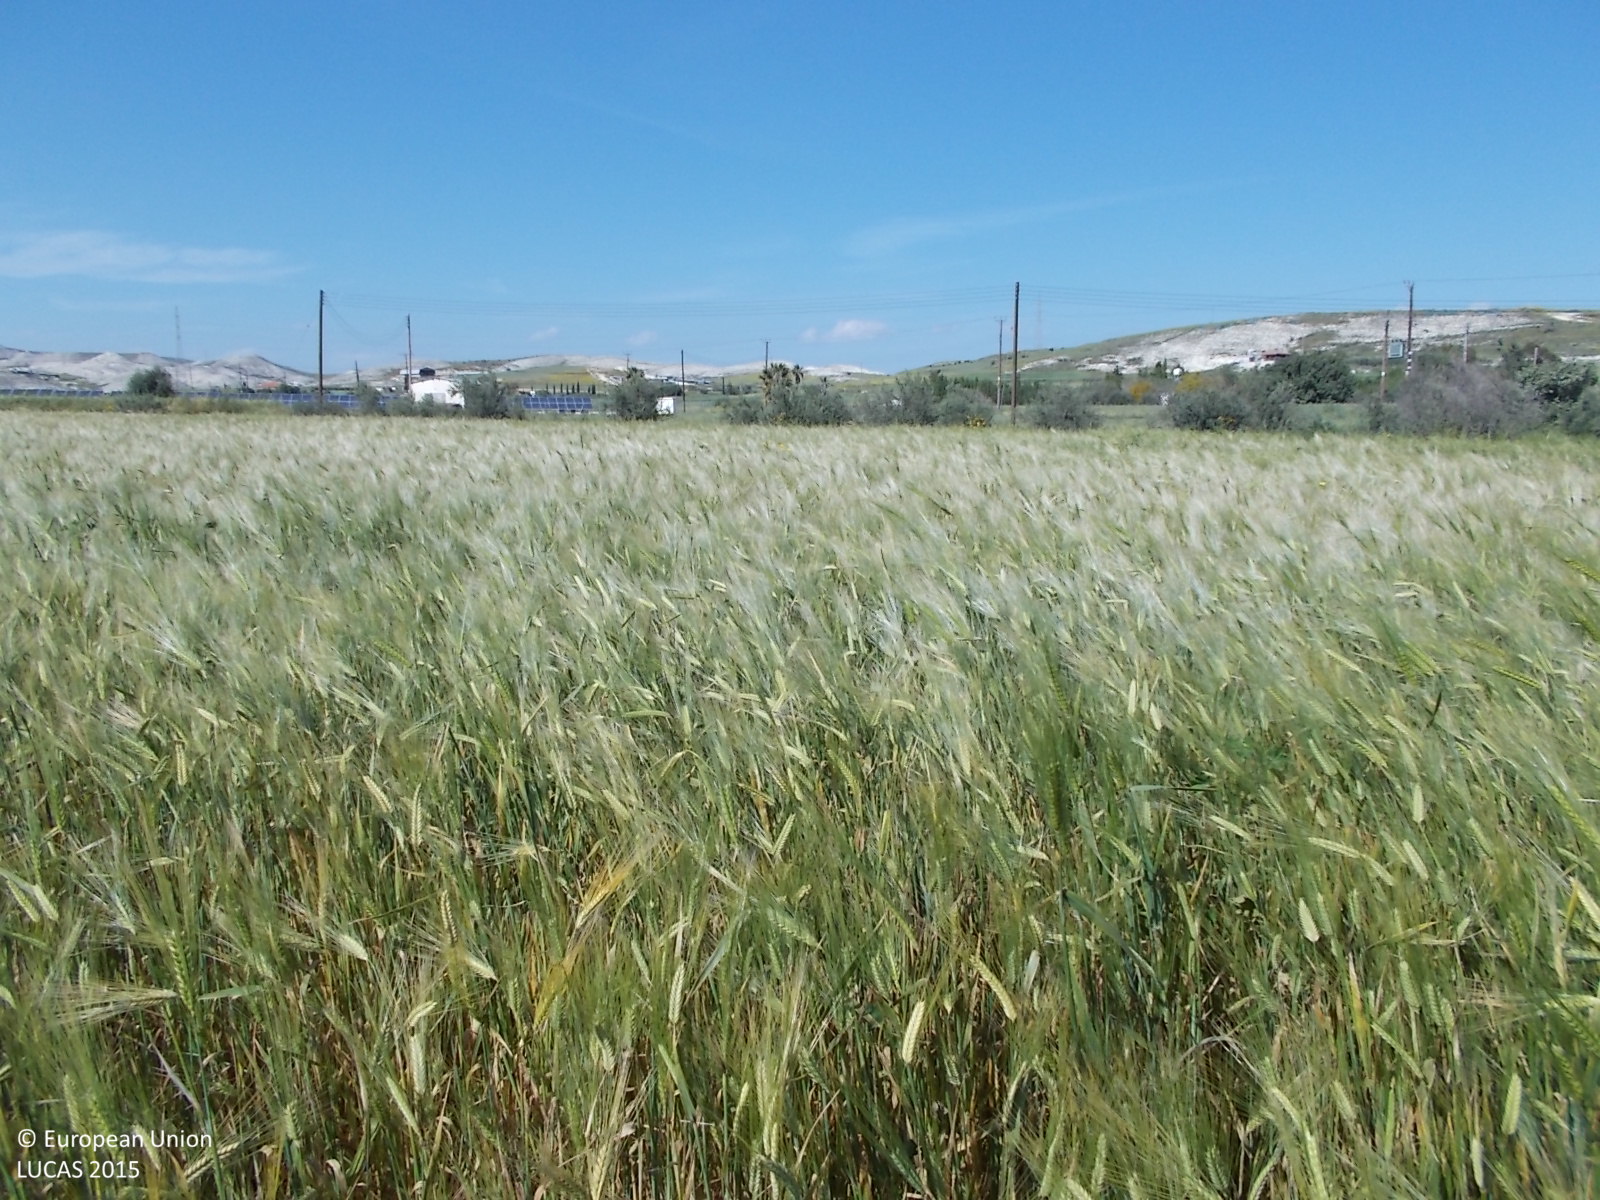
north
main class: Cropland
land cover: Barley
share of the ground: > 75 %
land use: Agriculture (excluding fallow land and kitchen gardens)
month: April
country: CY
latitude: 34.9688
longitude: 33.5571
